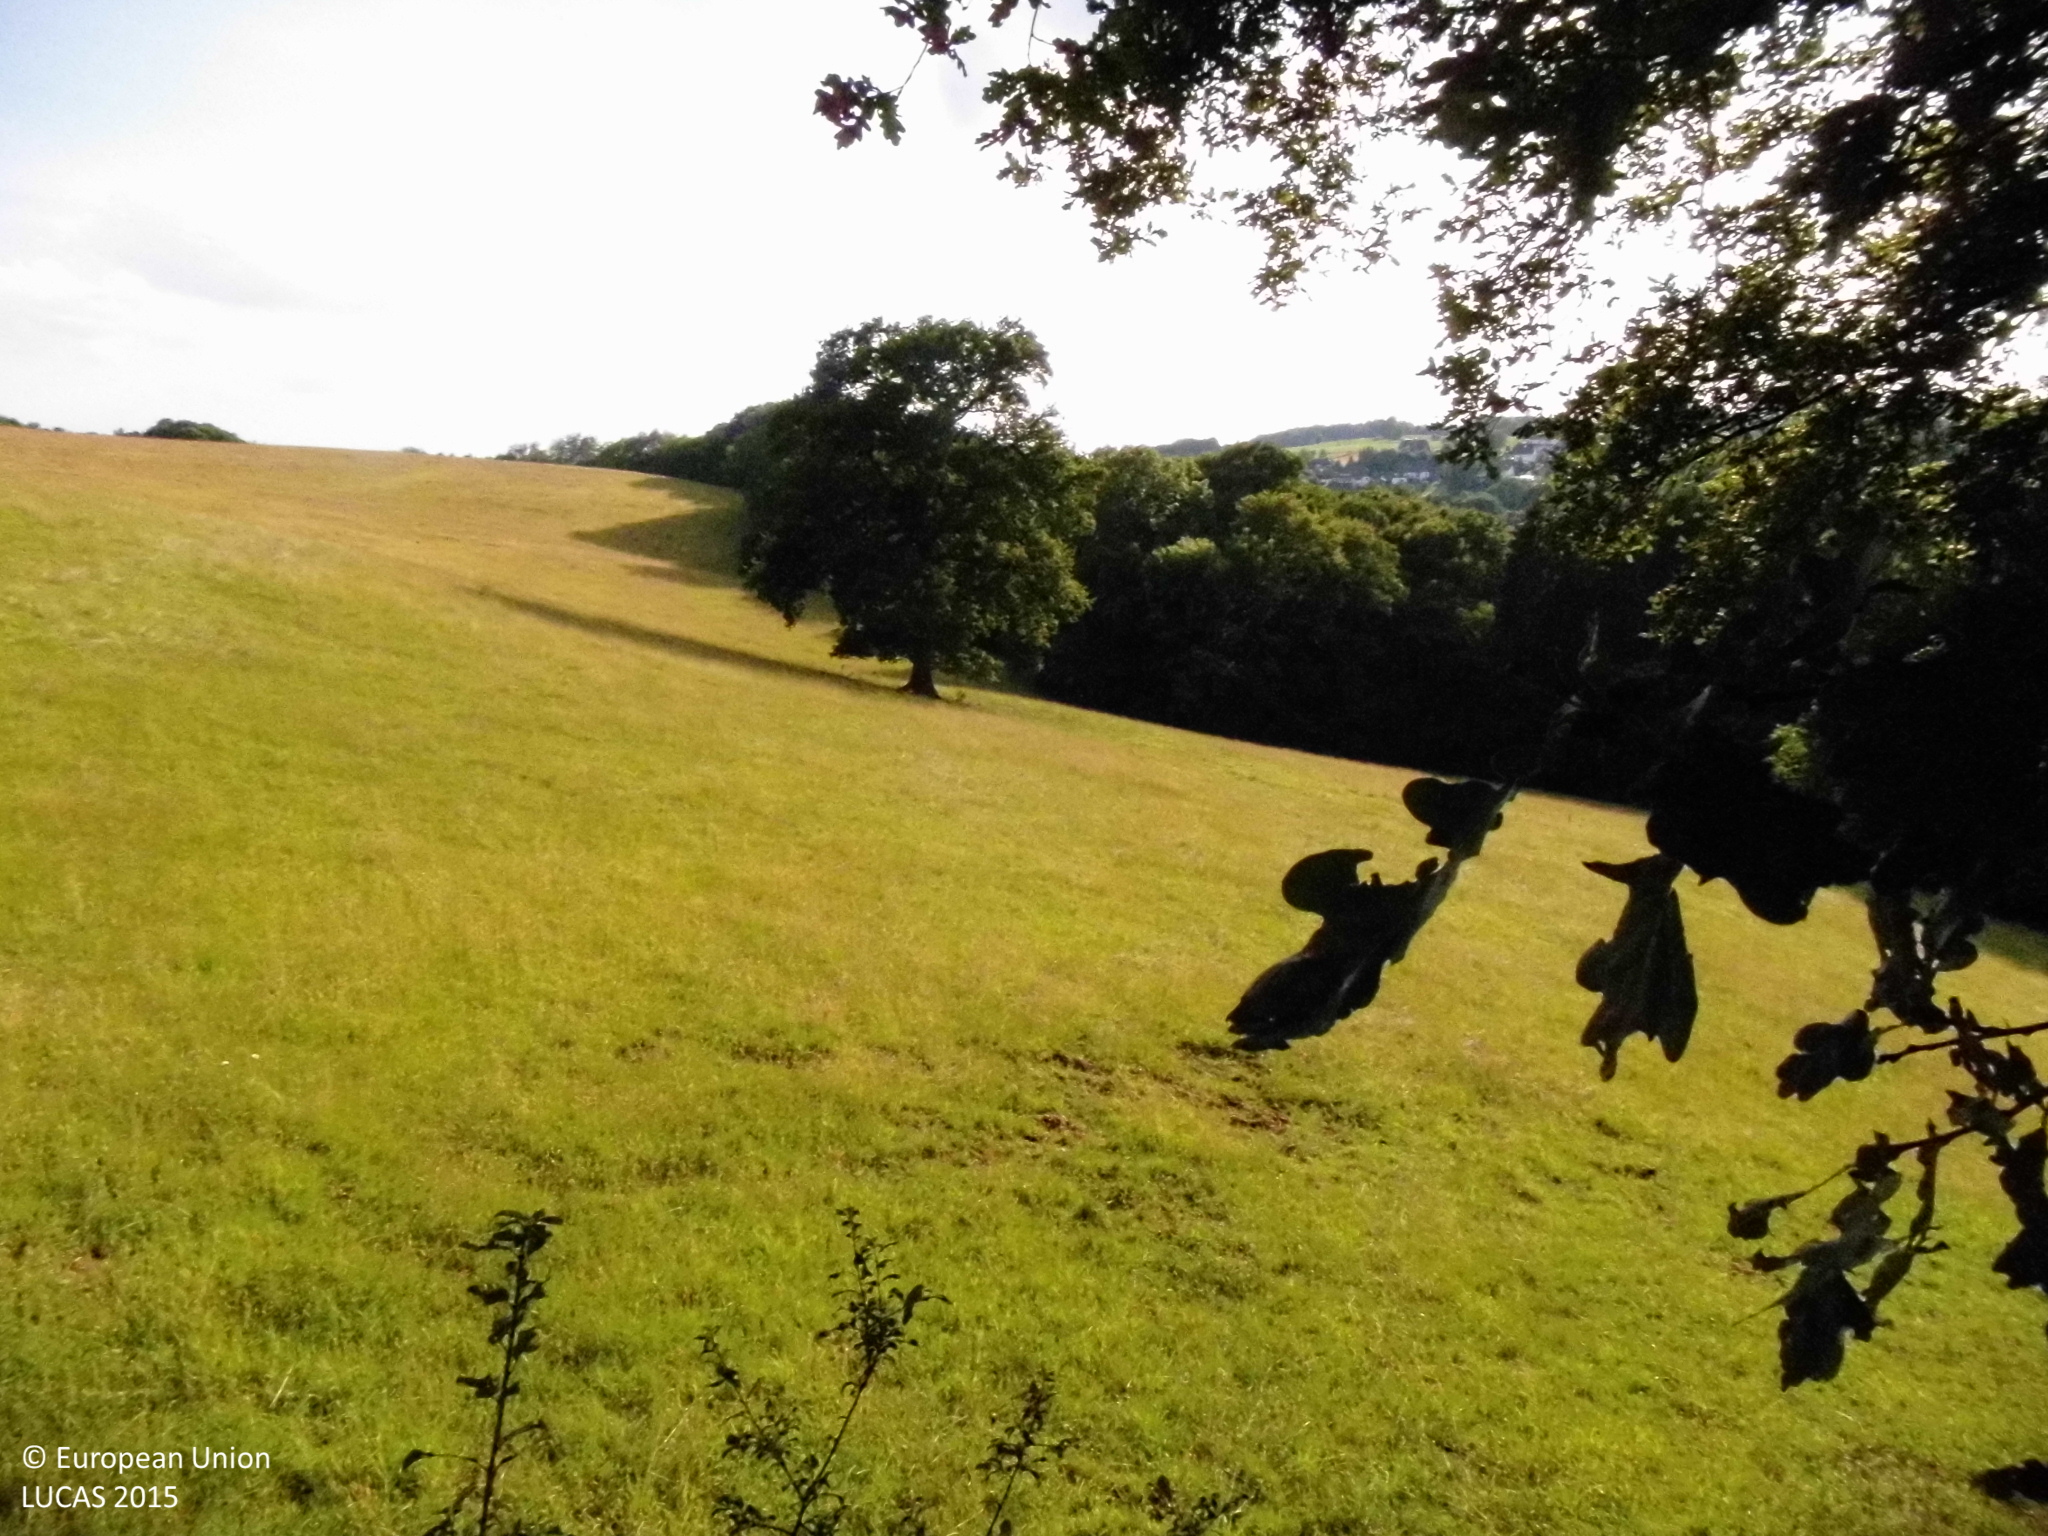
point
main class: Grassland
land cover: Grassland without tree/shrub cover
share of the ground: > 75 %
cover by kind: herbaceous plants 100 %
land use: Agriculture (excluding fallow land and kitchen gardens)
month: June
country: DE
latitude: 50.7856
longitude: 7.4612
